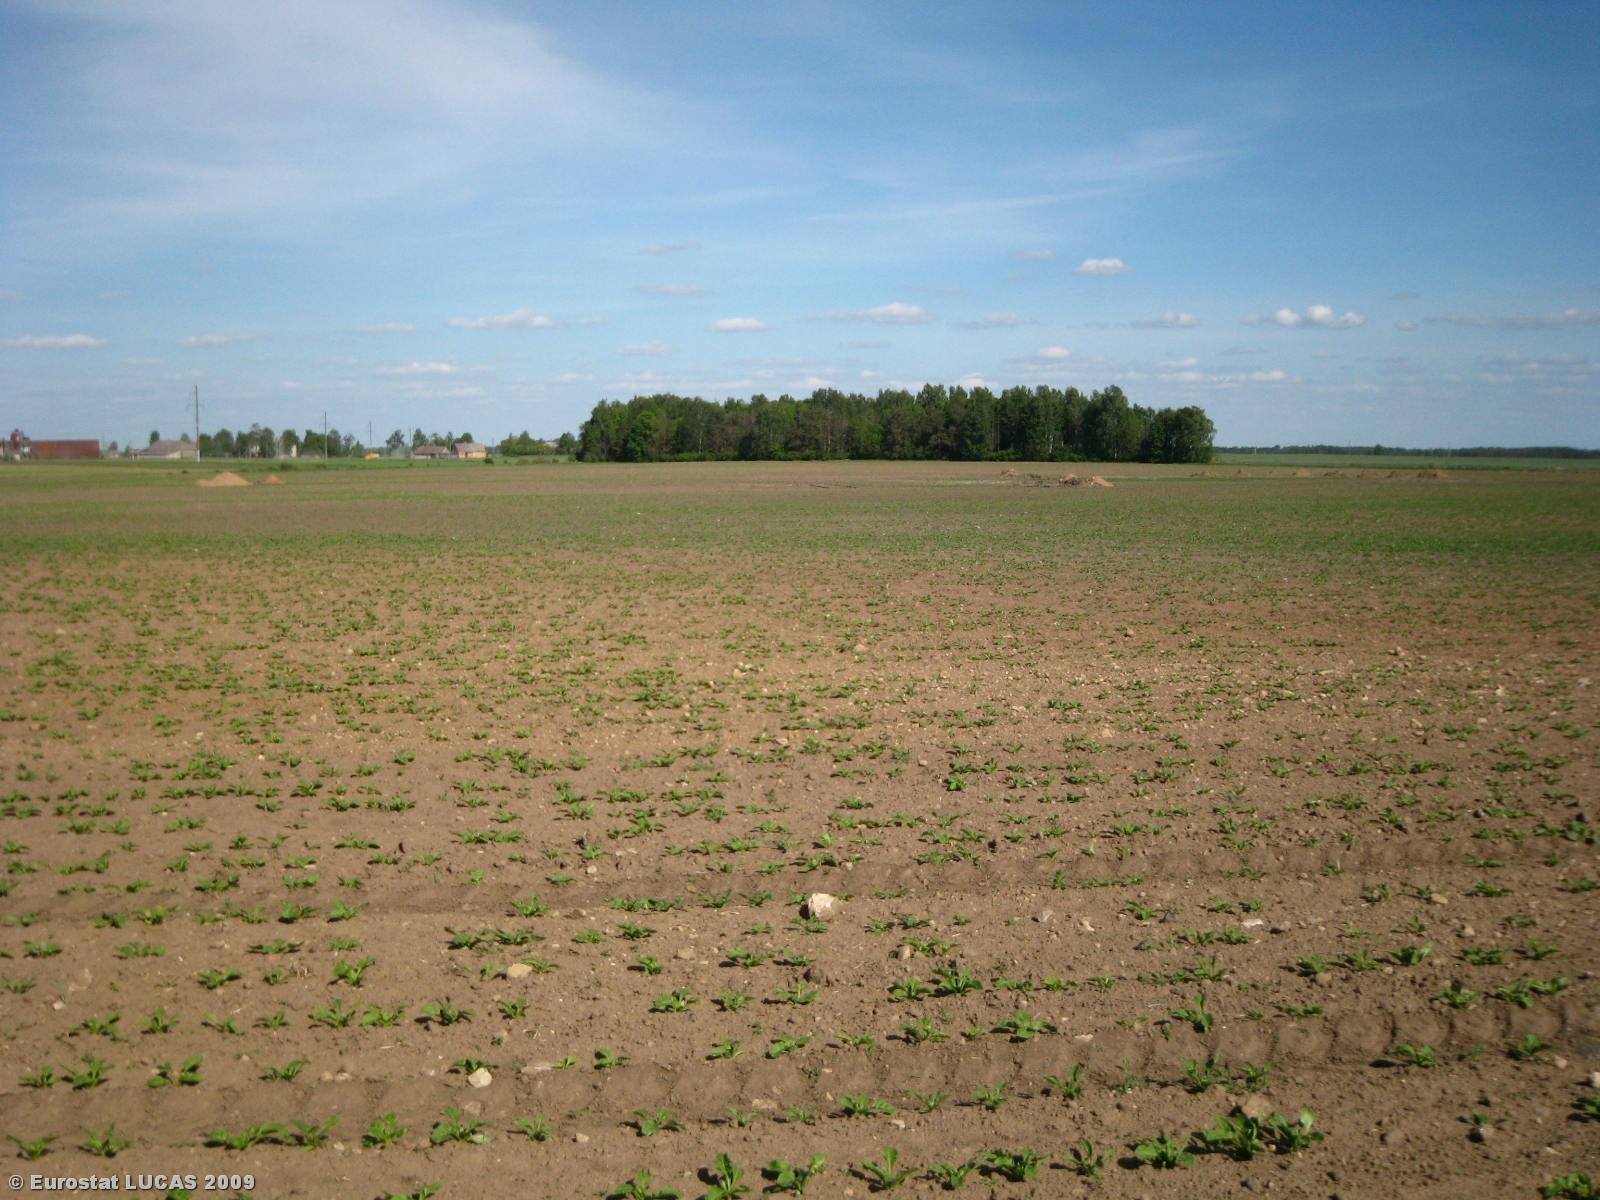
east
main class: Cropland
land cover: Sugar beet
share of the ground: 50 - 75 %
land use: Agriculture (excluding fallow land and kitchen gardens)
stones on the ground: < 10 %
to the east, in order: Sugar beet
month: May
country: LT
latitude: 55.7305
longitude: 23.9572
